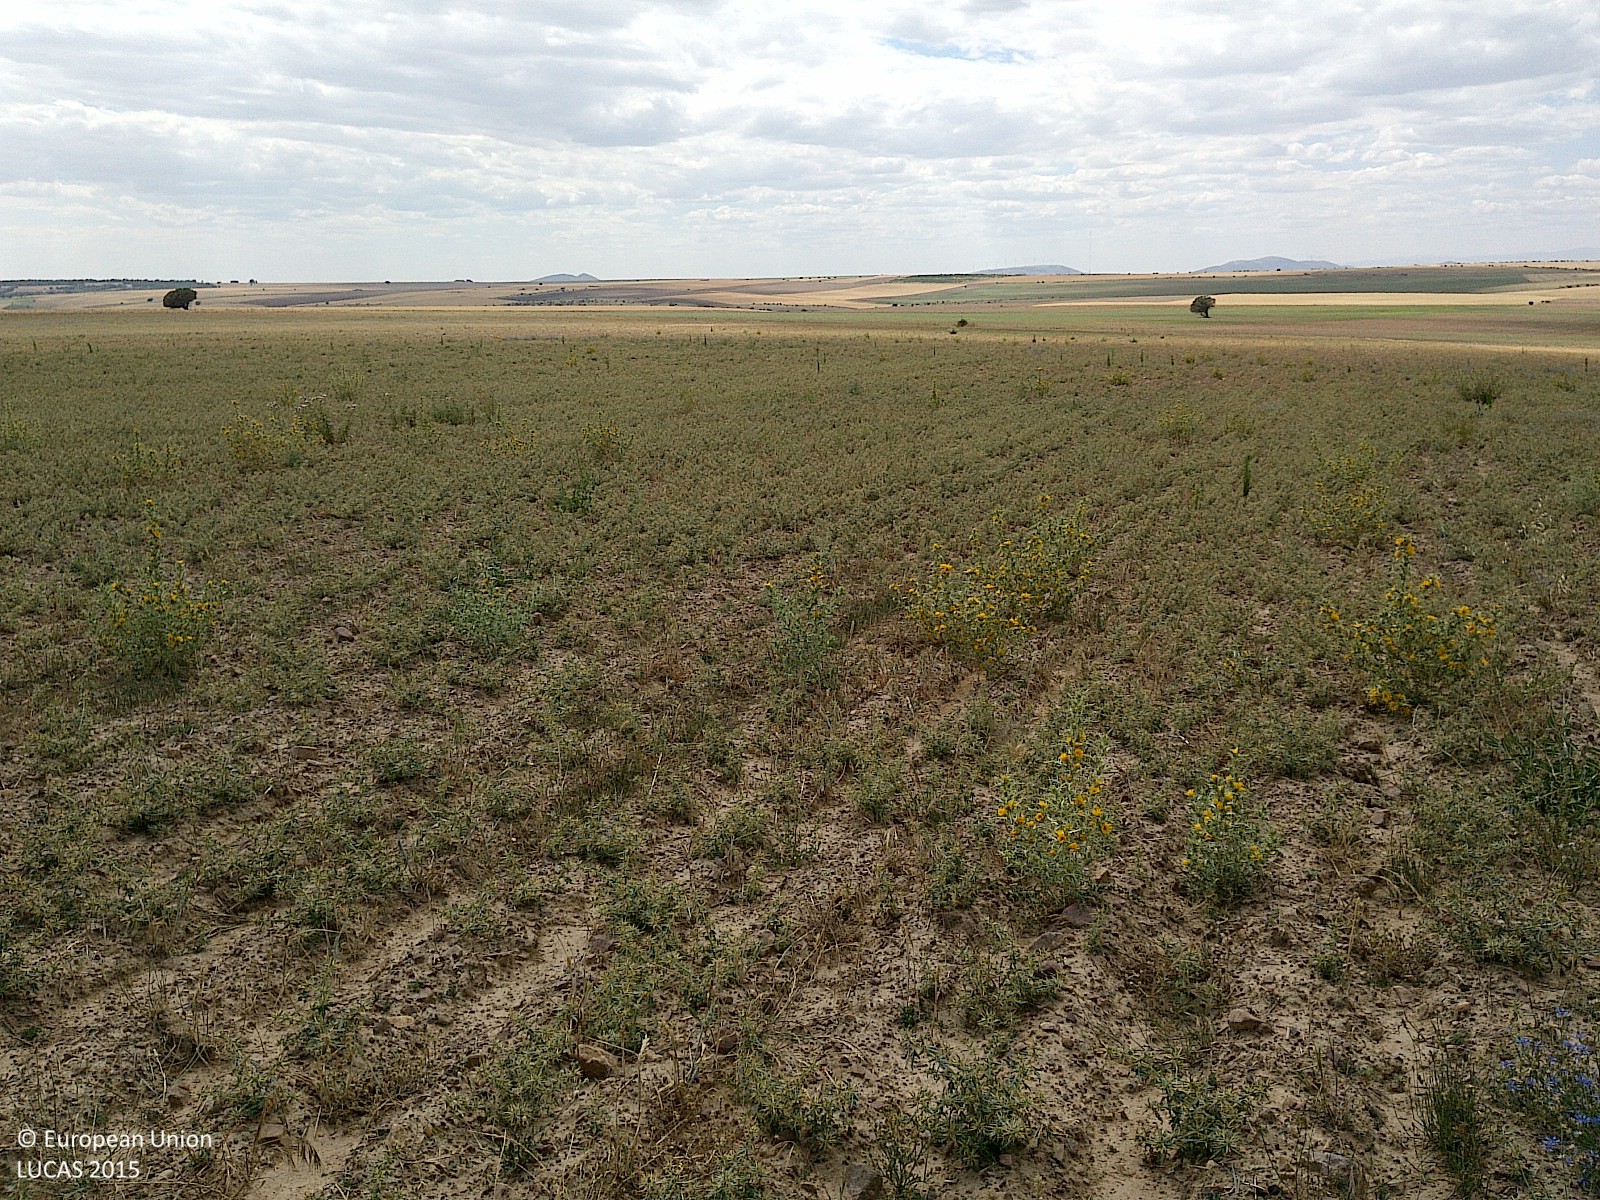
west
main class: Grassland
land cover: Spontaneously vegetated surfaces
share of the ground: 10 - 25 %
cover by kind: unconsolidated bare surface 85 %, herbaceous plants 15 %
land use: Fallow land
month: July
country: ES
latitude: 41.6721
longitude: -1.9345
